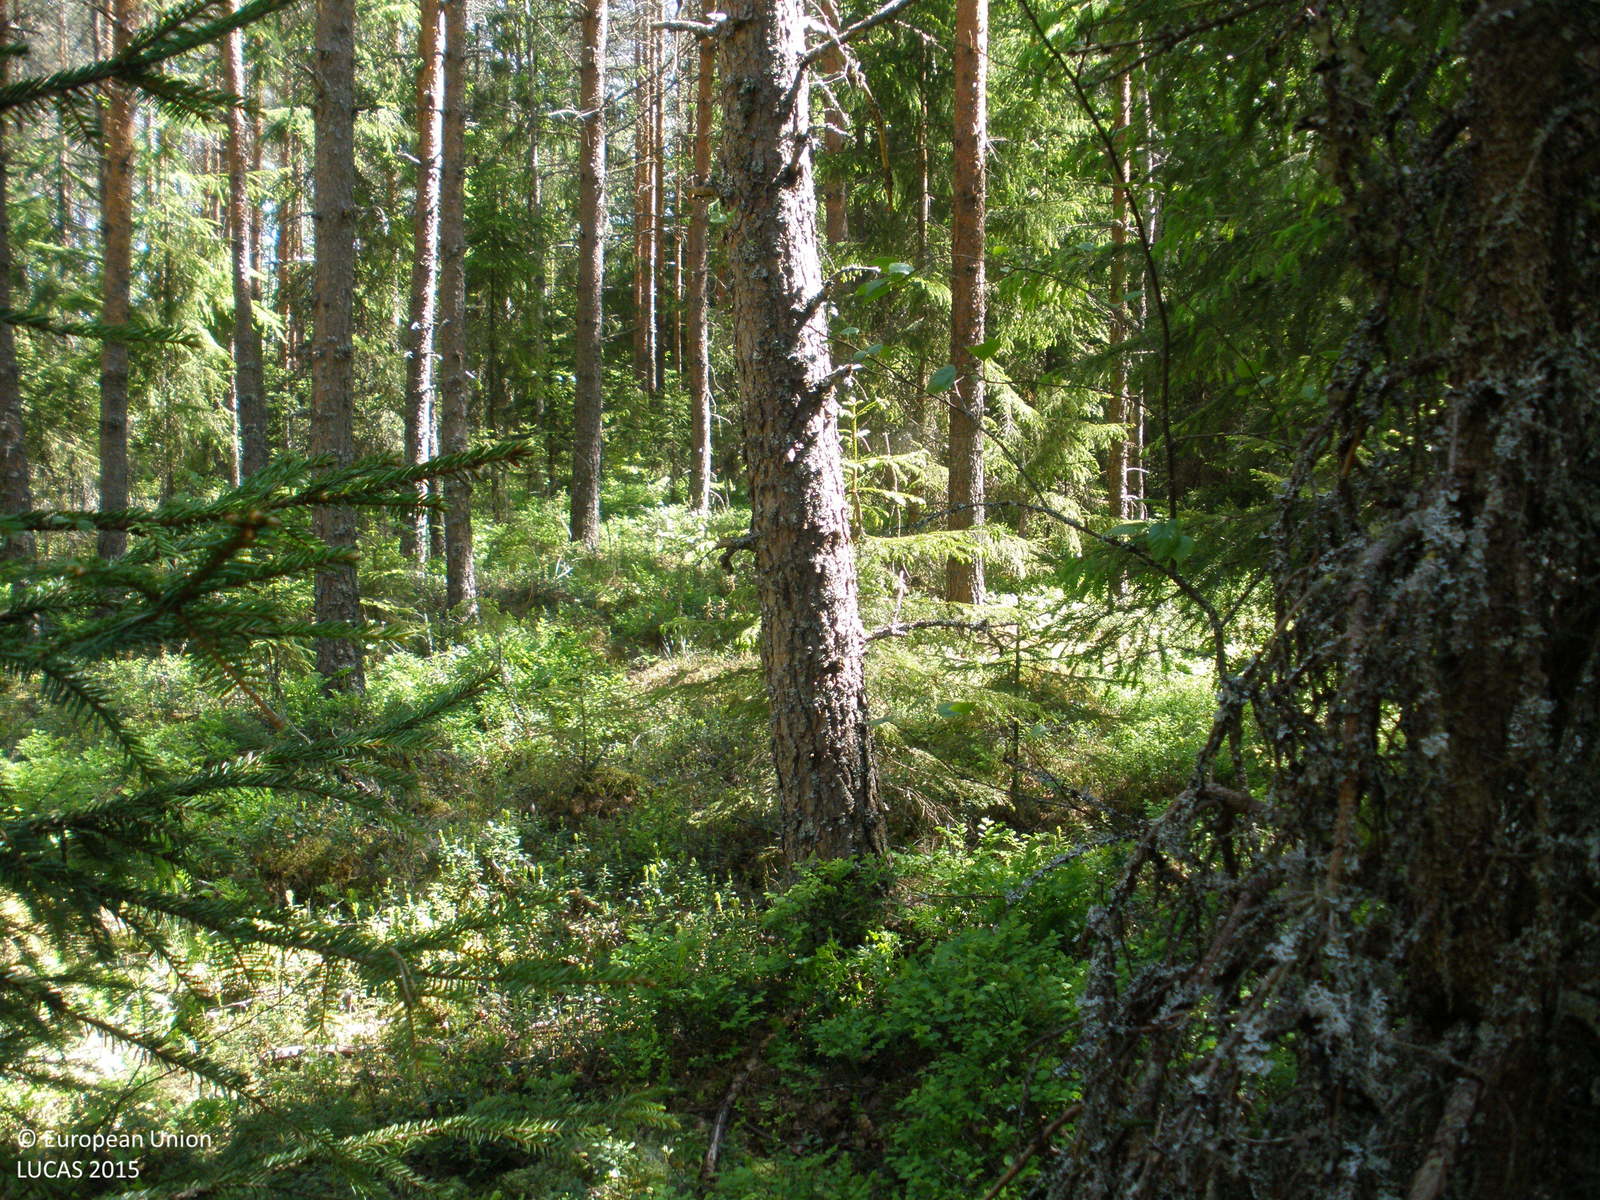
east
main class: Woodland
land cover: Pine dominated coniferous woodland
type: boreal forest
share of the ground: > 75 %
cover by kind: coniferous forest trees 80 %, herbaceous plants 10 %, broadleaved forest trees 5 %, lichens and mosses 5 %
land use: Forestry
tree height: > 5 m
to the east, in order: Pine dominated coniferous woodland; Ditches and canals; Pine dominated coniferous woodland
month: June
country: FI
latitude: 60.7687
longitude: 23.5417
